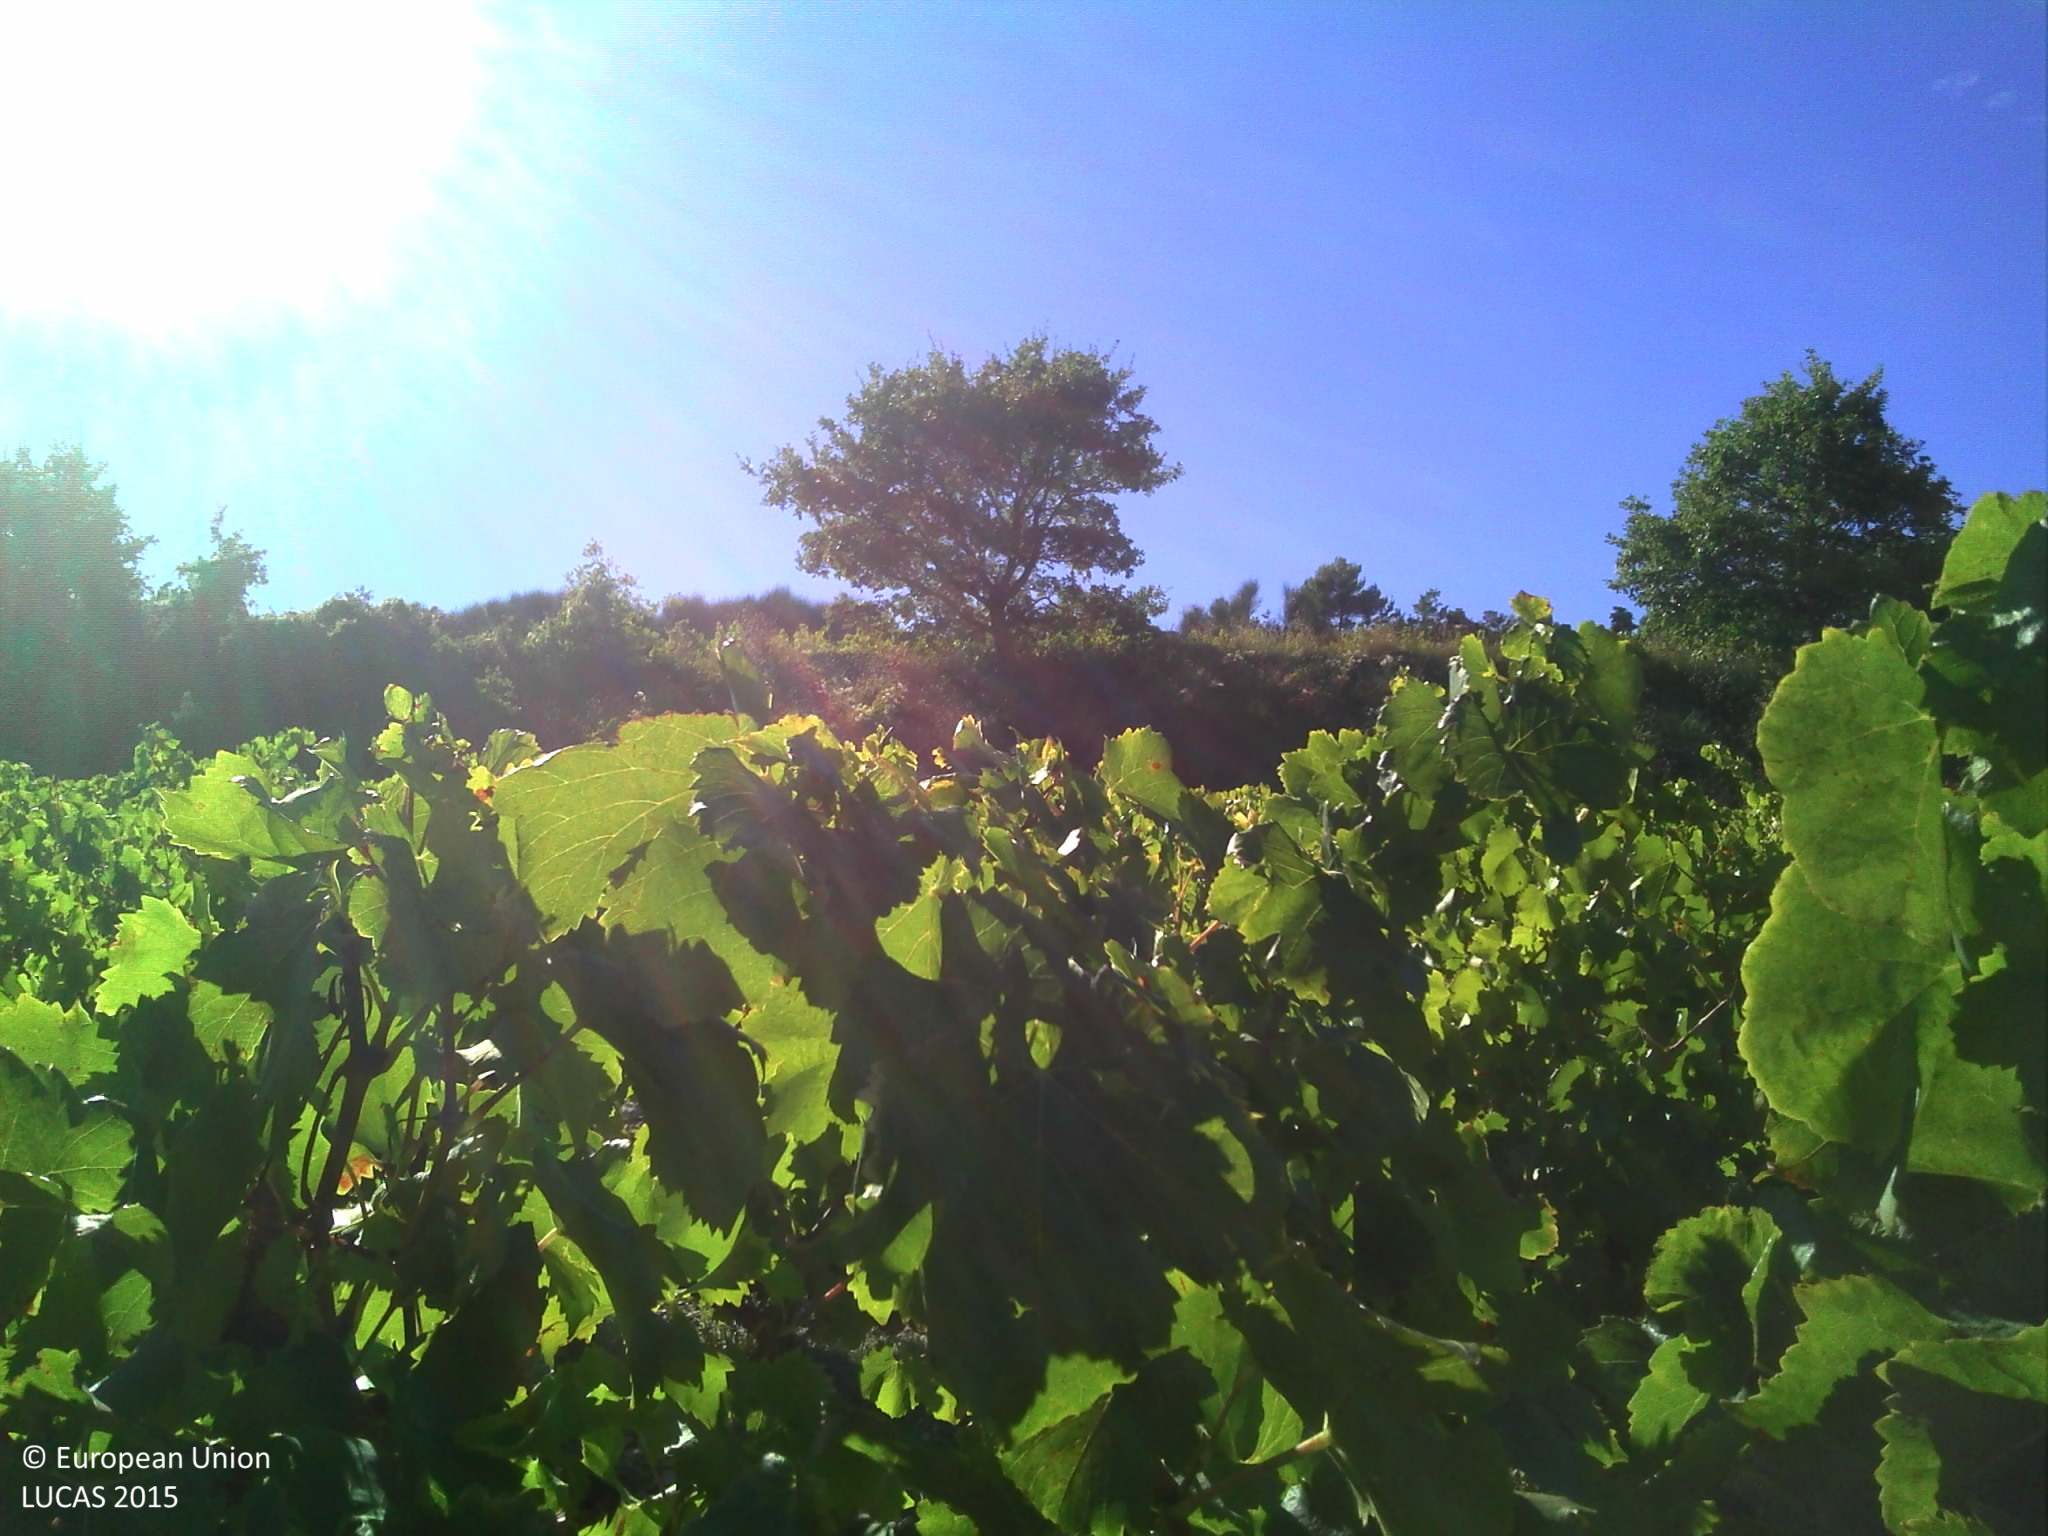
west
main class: Cropland
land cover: Vineyards
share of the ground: 10 - 25 %
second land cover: Spontaneously vegetated surfaces
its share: > 75 %
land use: Agriculture (excluding fallow land and kitchen gardens)
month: September
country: FR
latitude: 44.3614
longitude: 5.1014
